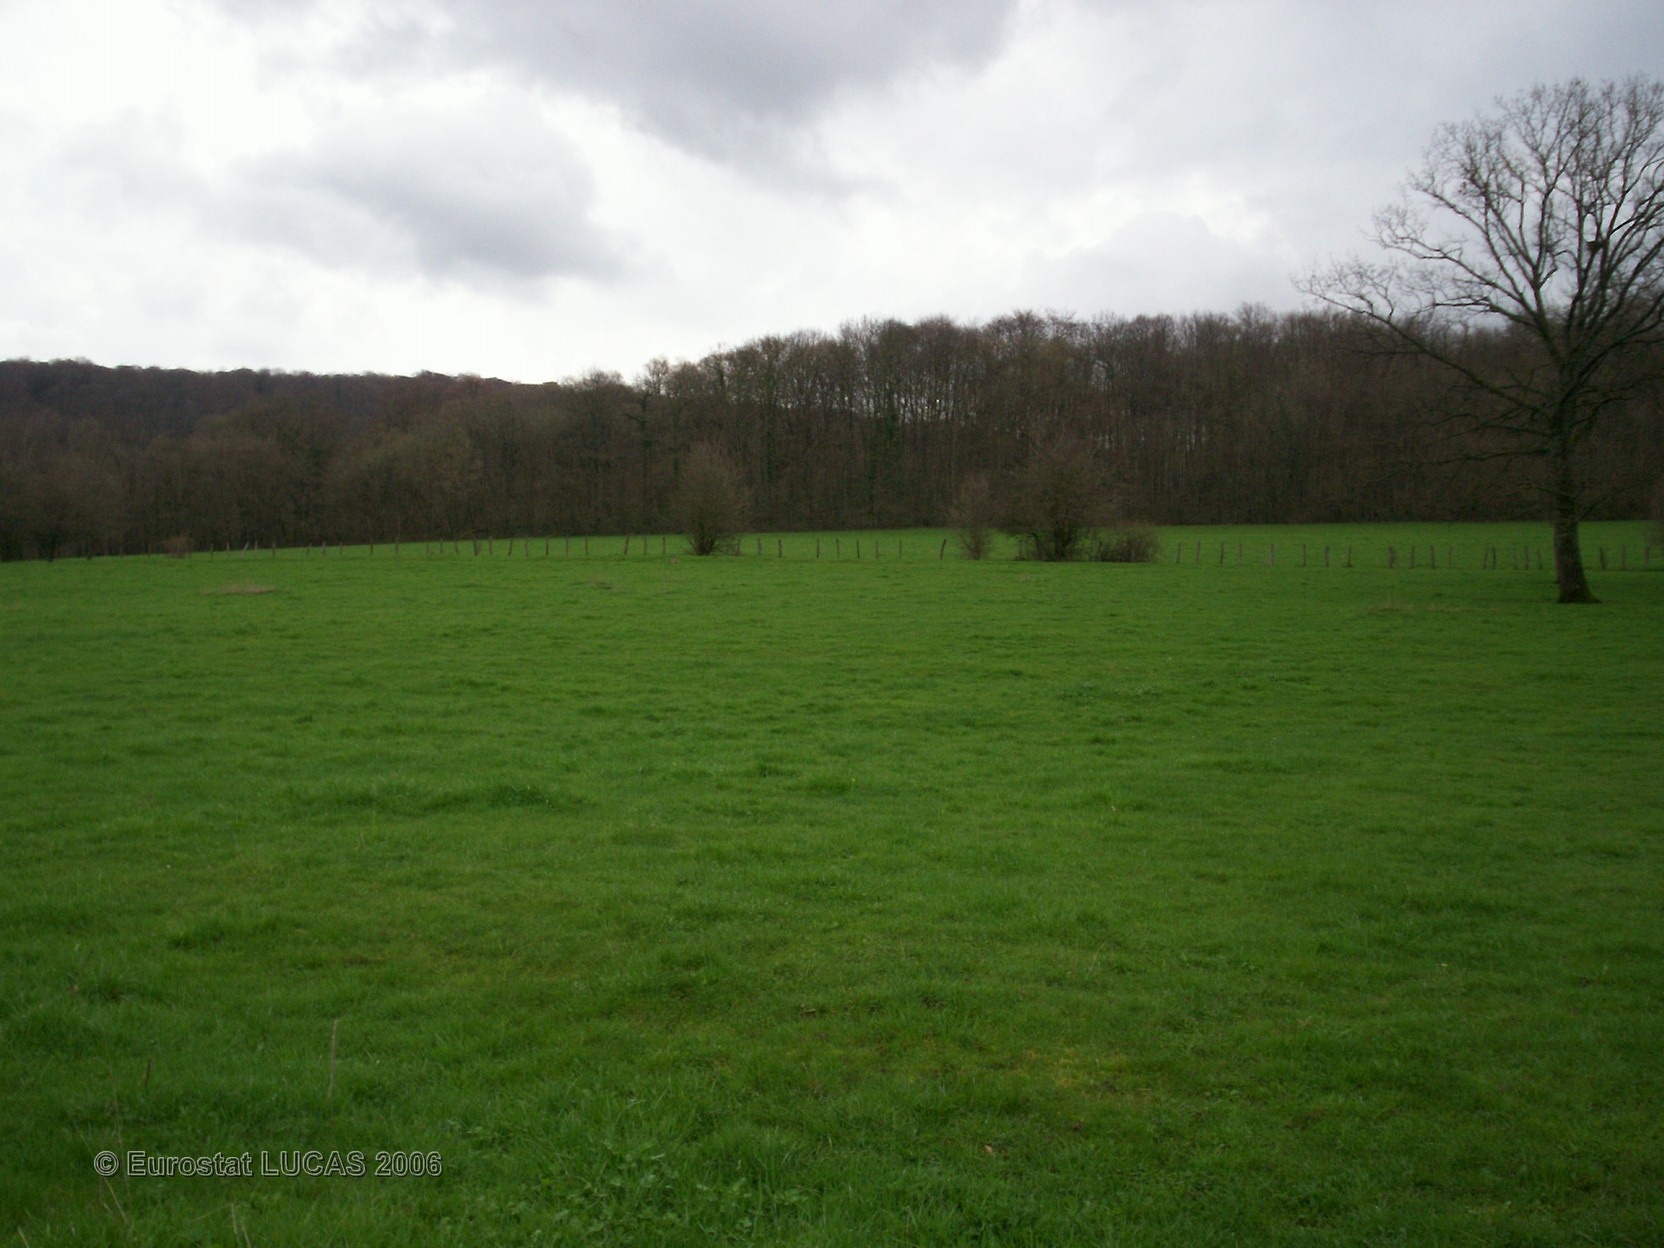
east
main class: Grassland
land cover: Grassland with sparse tree/shrub cover
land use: Agriculture (excluding fallow land and kitchen gardens)
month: April
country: FR
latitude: 47.5419
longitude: 6.6403
